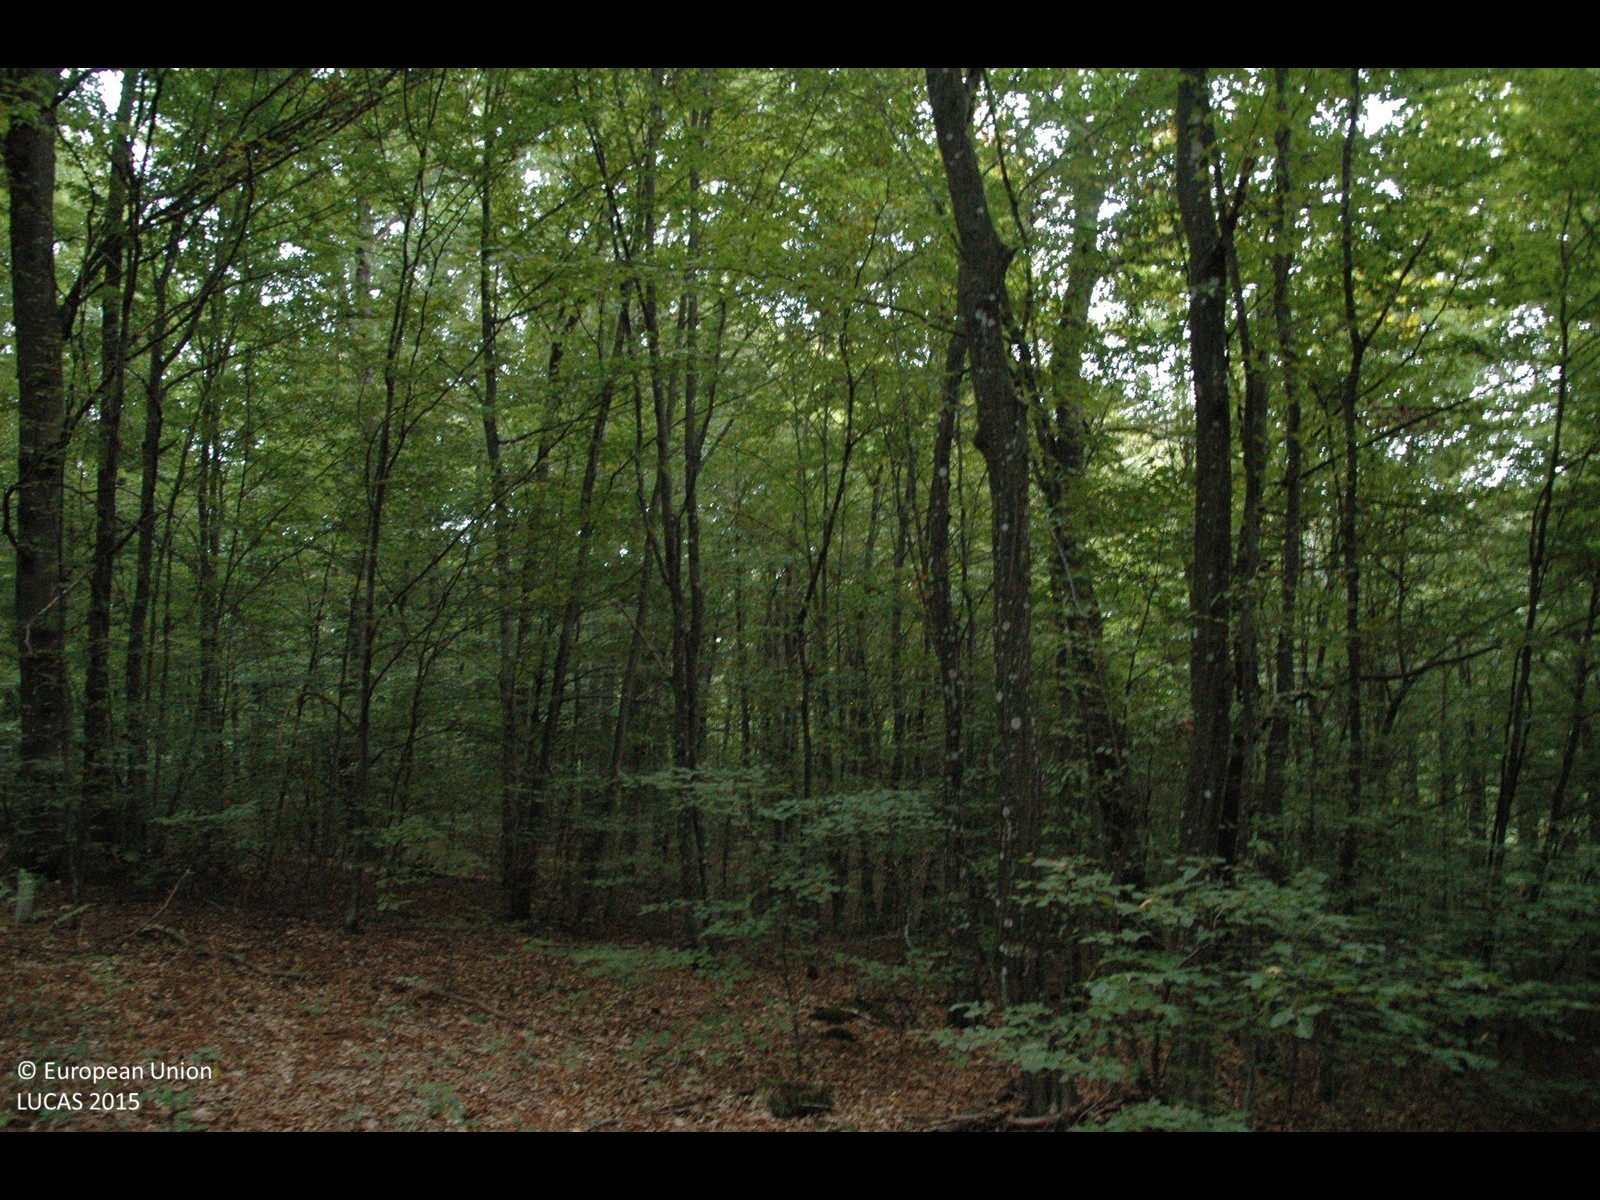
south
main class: Woodland
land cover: Broadleaved woodland
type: mesophytic deciduous forest
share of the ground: > 75 %
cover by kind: broadleaved forest trees 100 %
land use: Forestry
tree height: > 5 m
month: October
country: HR
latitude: 45.5804
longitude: 16.1107
